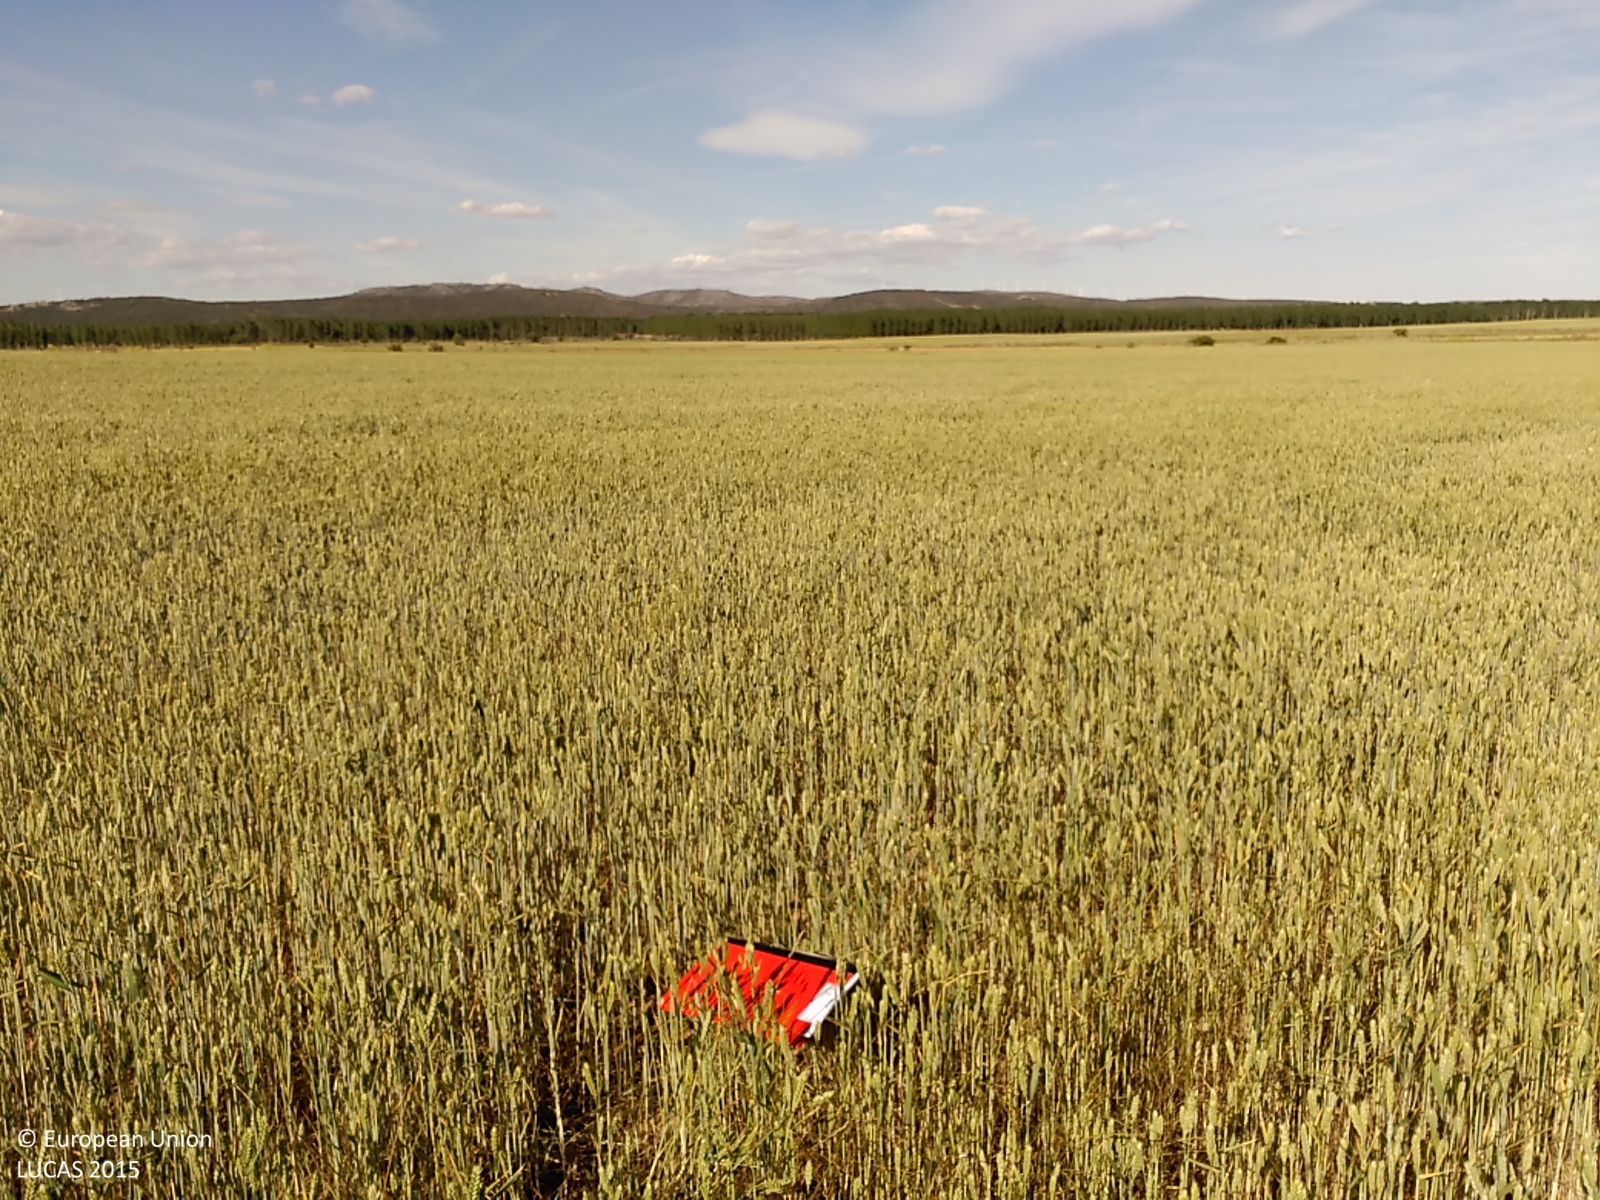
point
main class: Cropland
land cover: Common wheat
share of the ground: > 75 %
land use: Agriculture (excluding fallow land and kitchen gardens)
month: May
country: ES
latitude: 42.0581
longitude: -5.9646
